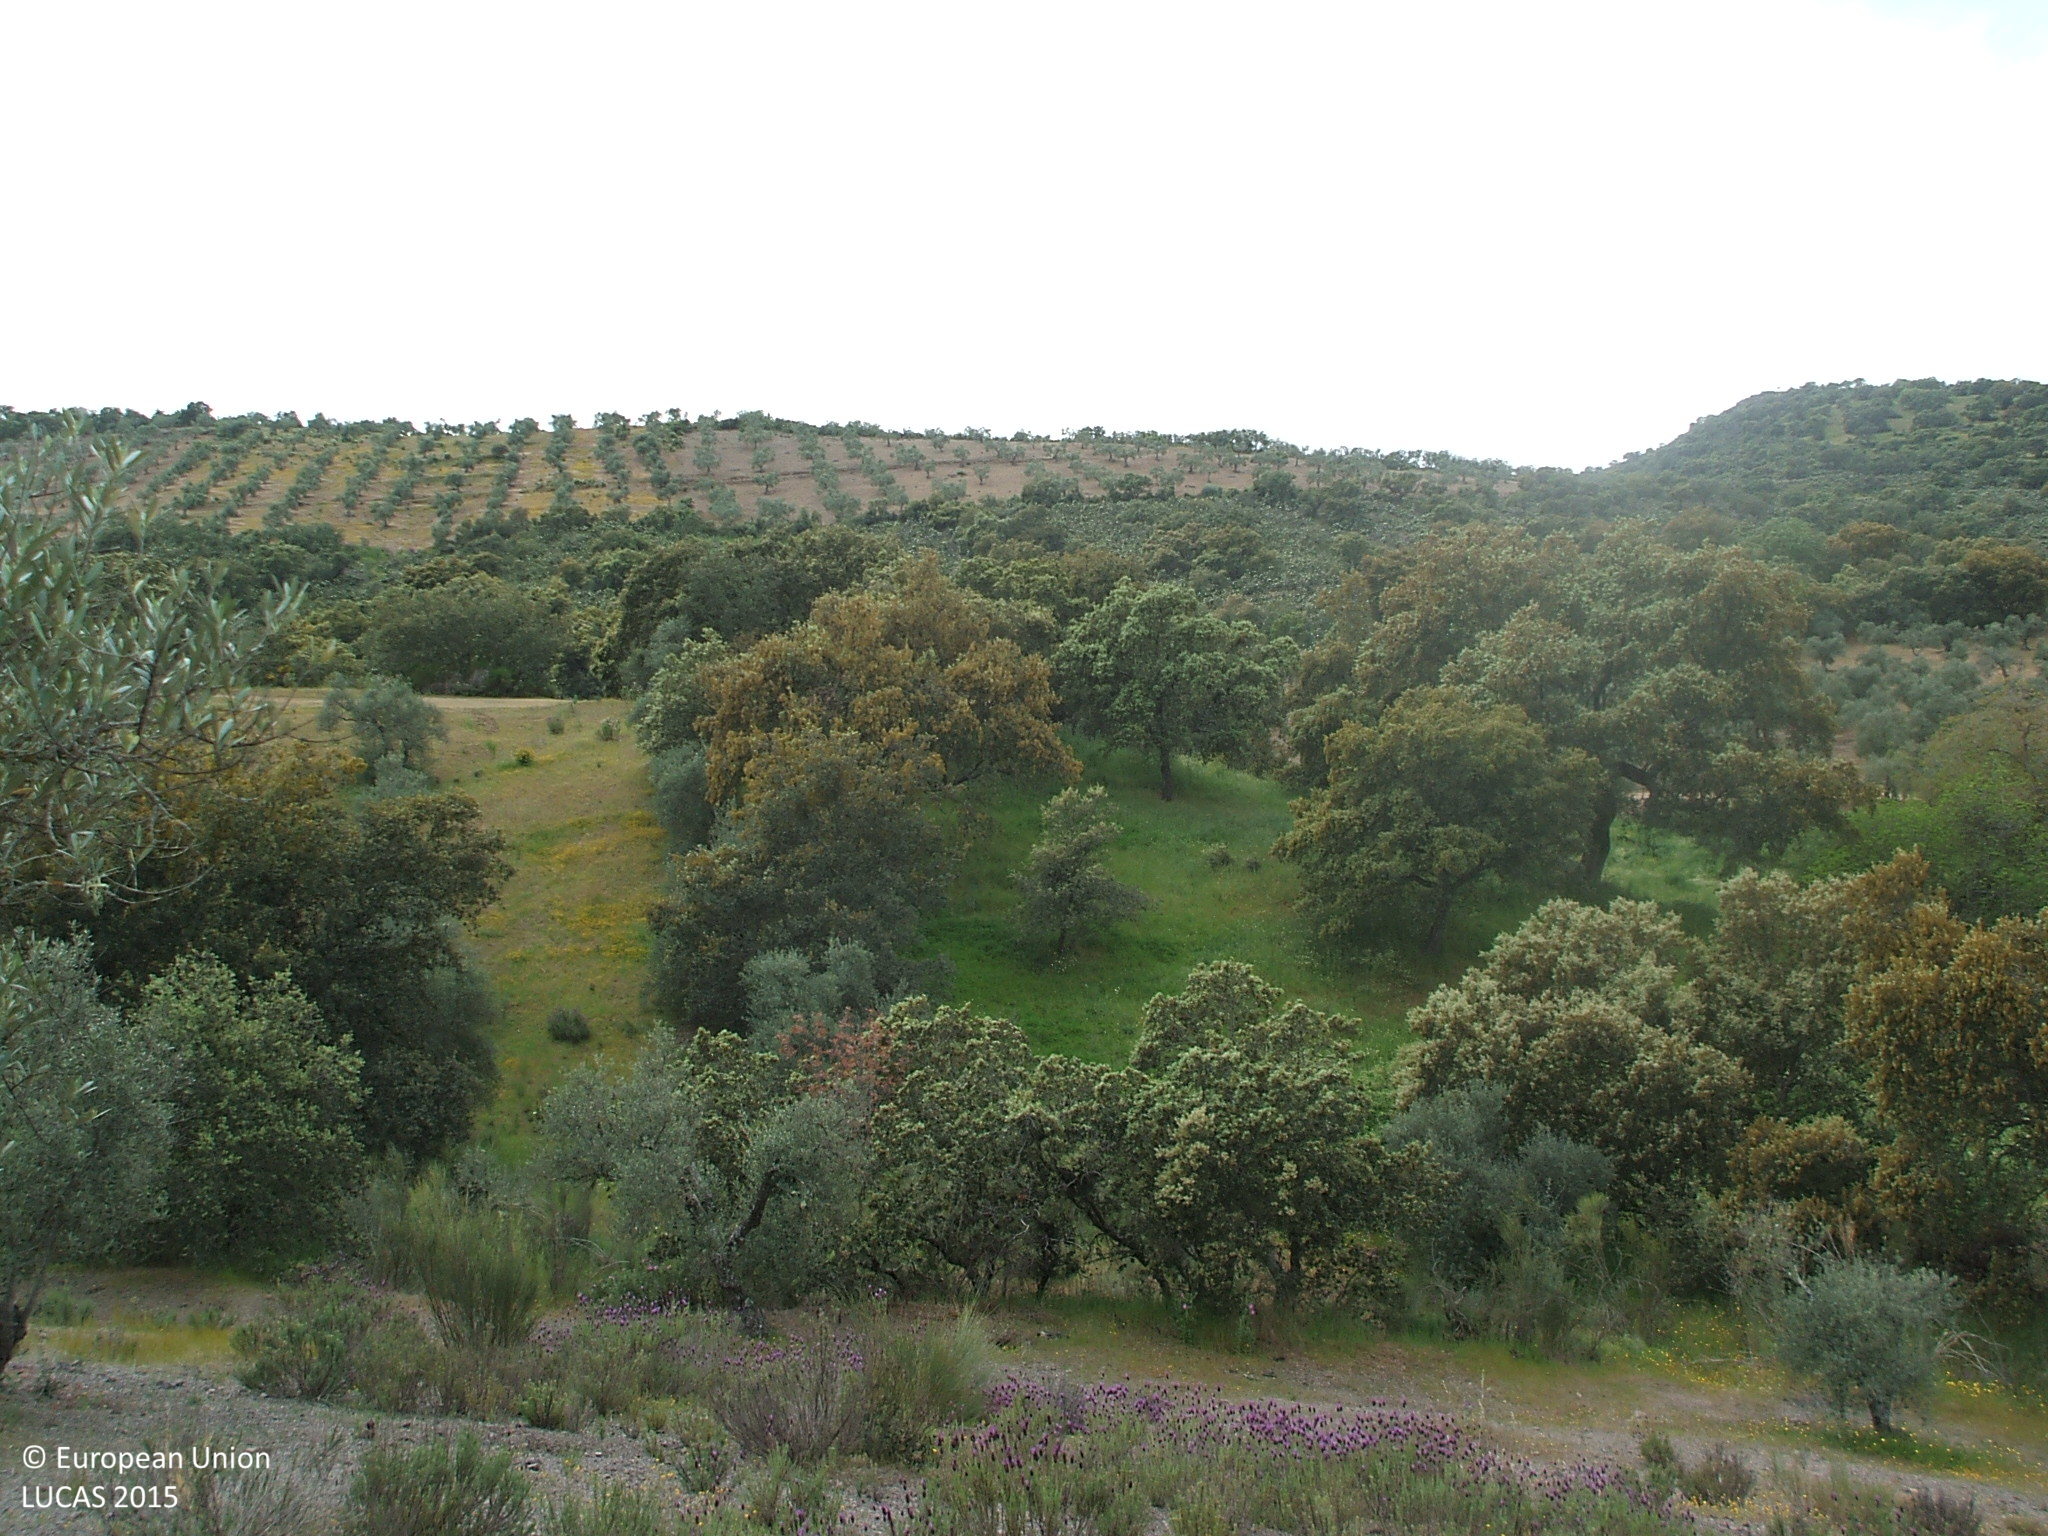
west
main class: Cropland
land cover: Olive groves
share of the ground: 10 - 25 %
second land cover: Shrubland without tree cover
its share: 10 - 25 %
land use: Agriculture (excluding fallow land and kitchen gardens)
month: April
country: ES
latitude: 38.1265
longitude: -5.7181
